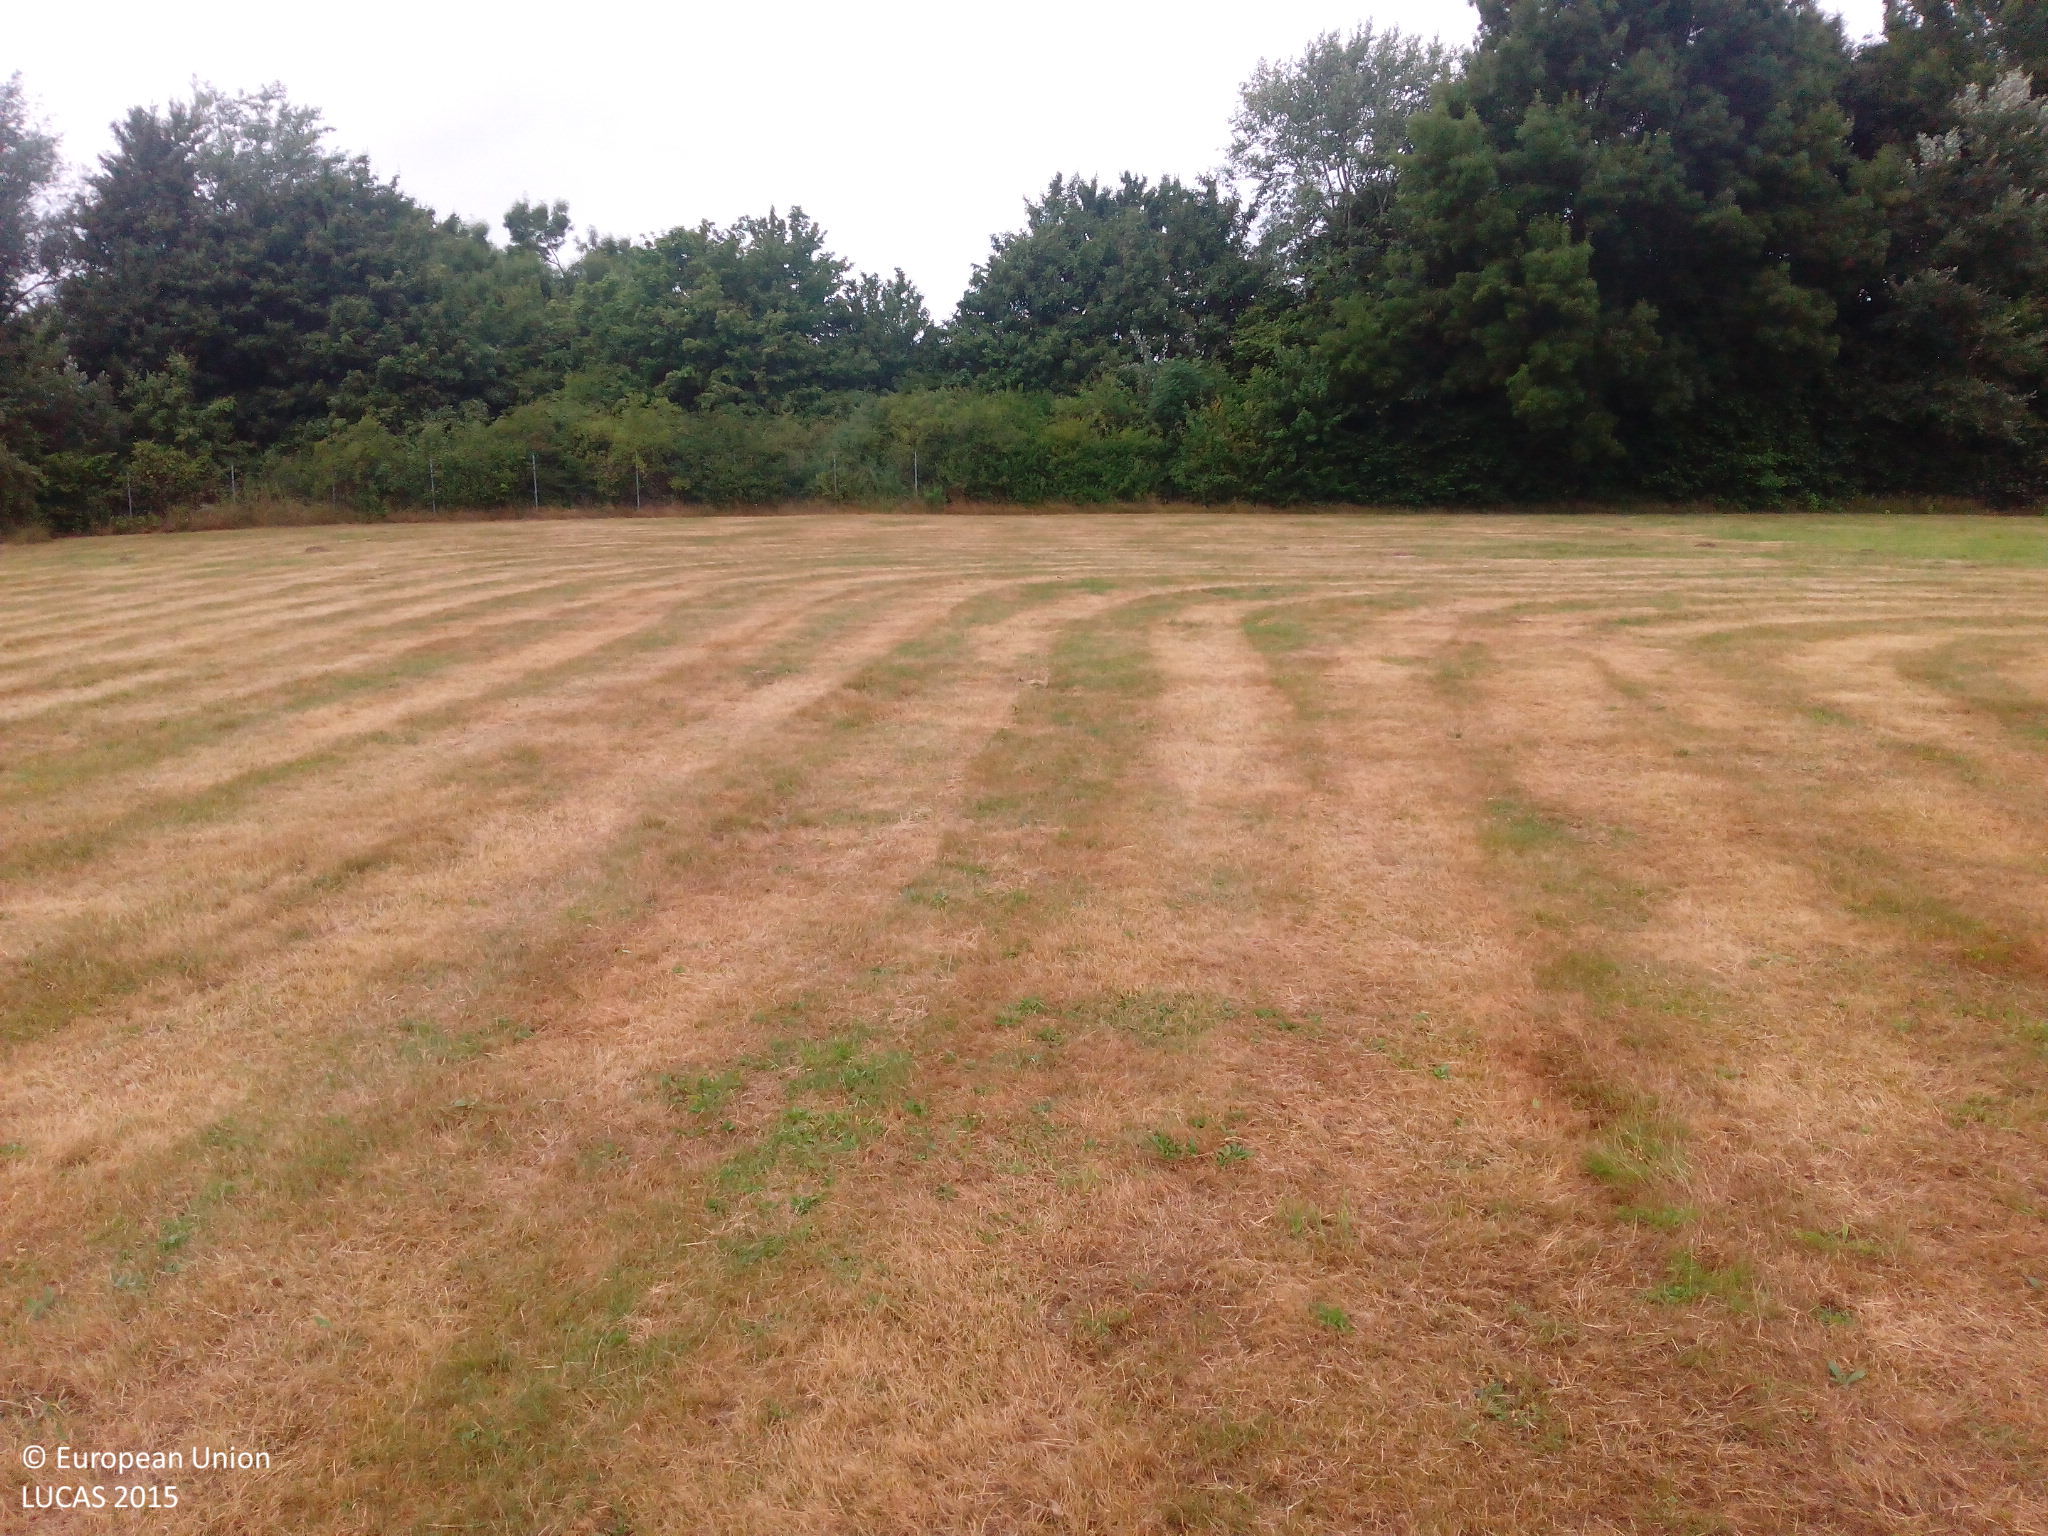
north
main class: Grassland
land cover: Grassland without tree/shrub cover
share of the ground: > 75 %
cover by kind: herbaceous plants 100 %
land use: Amenities, museums, leisure
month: July
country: NL
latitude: 51.8258
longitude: 5.5439
